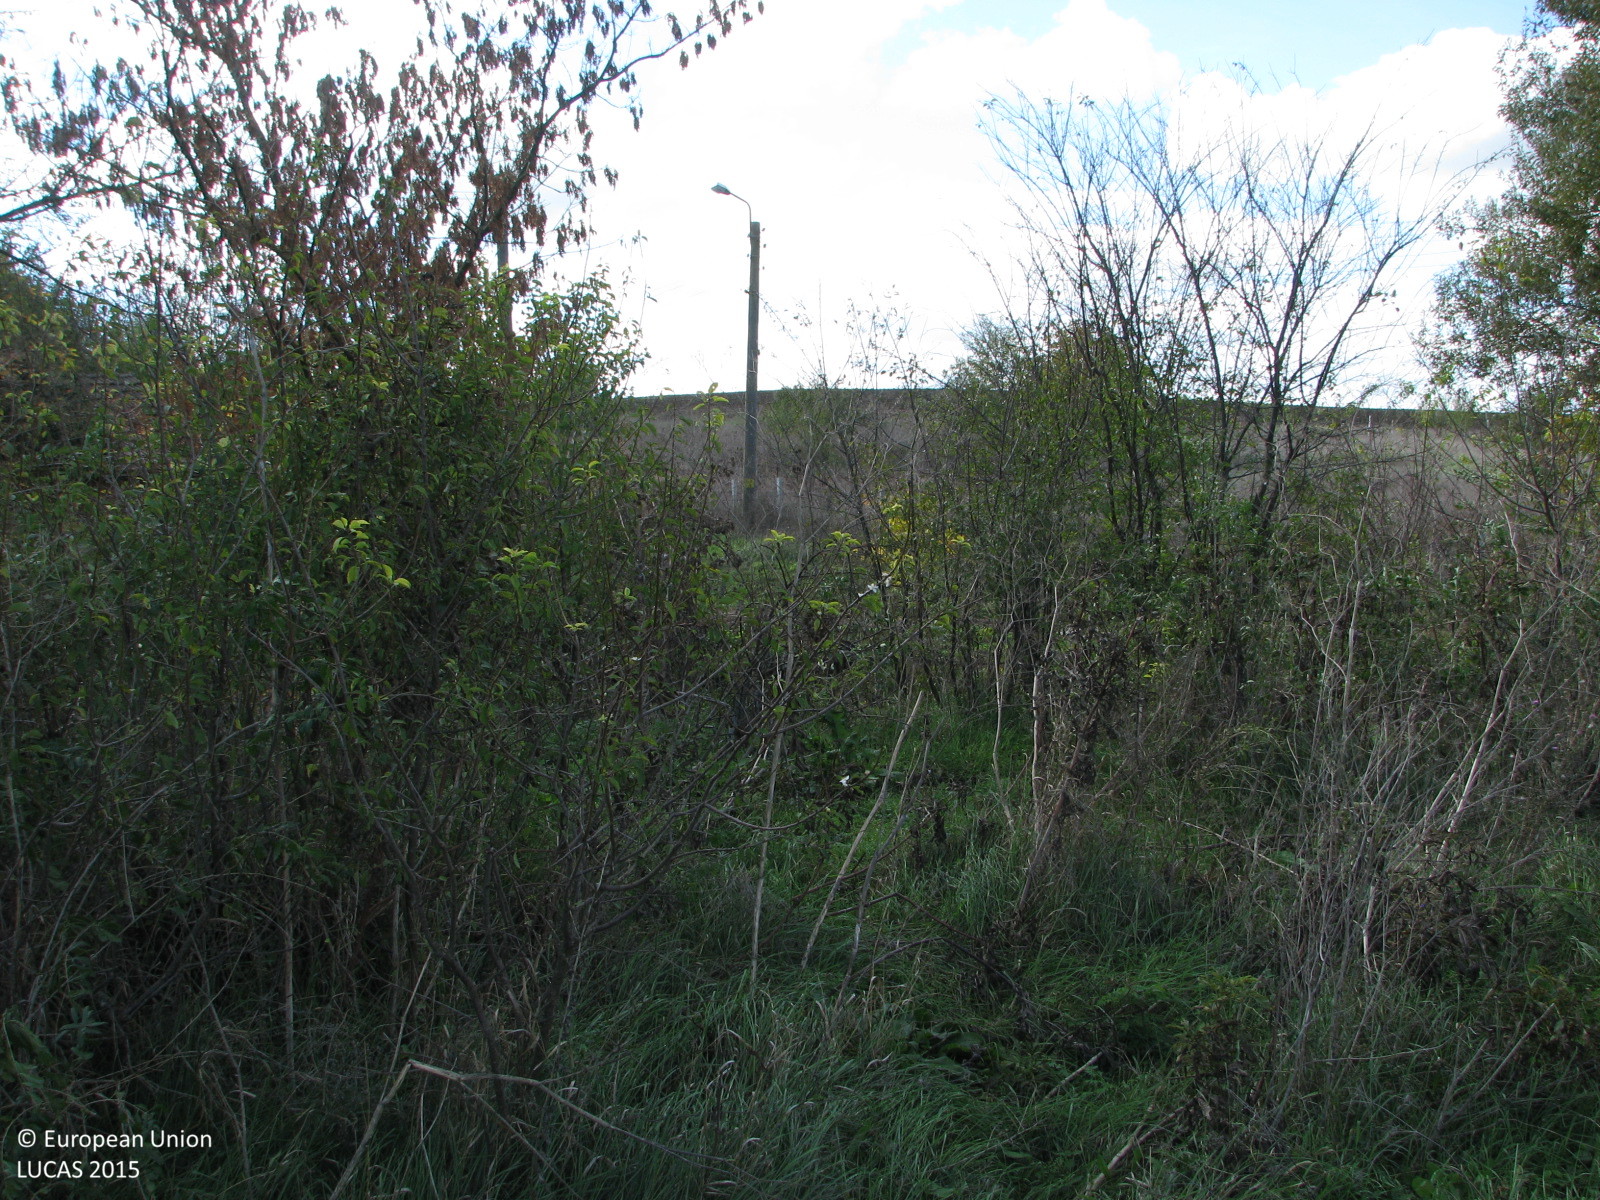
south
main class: Grassland
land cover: Grassland without tree/shrub cover
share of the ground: > 75 %
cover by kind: herbaceous plants 100 %
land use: Sport
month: October
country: BG
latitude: 42.3358
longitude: 26.7354
